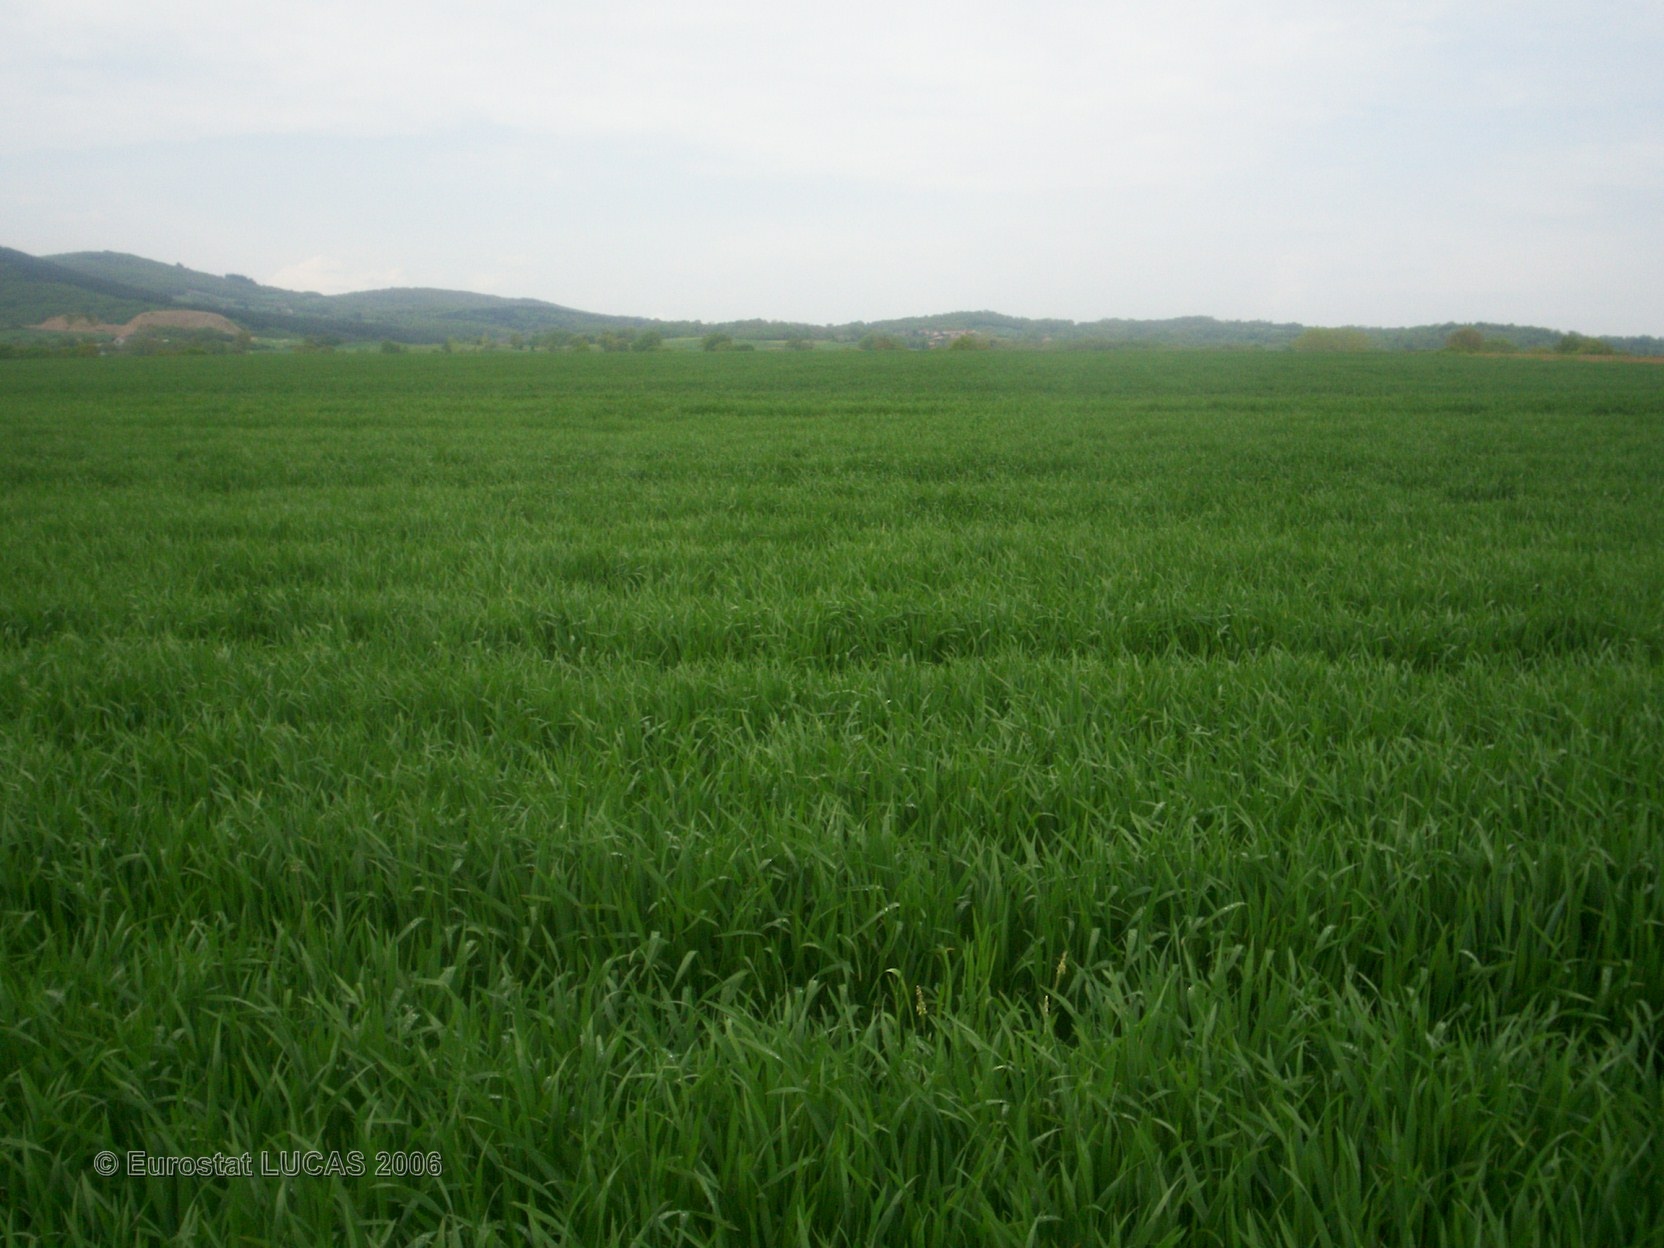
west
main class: Cropland
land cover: Common wheat
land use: Agriculture (excluding fallow land and kitchen gardens)
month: May
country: FR
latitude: 46.0012
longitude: 3.0907
